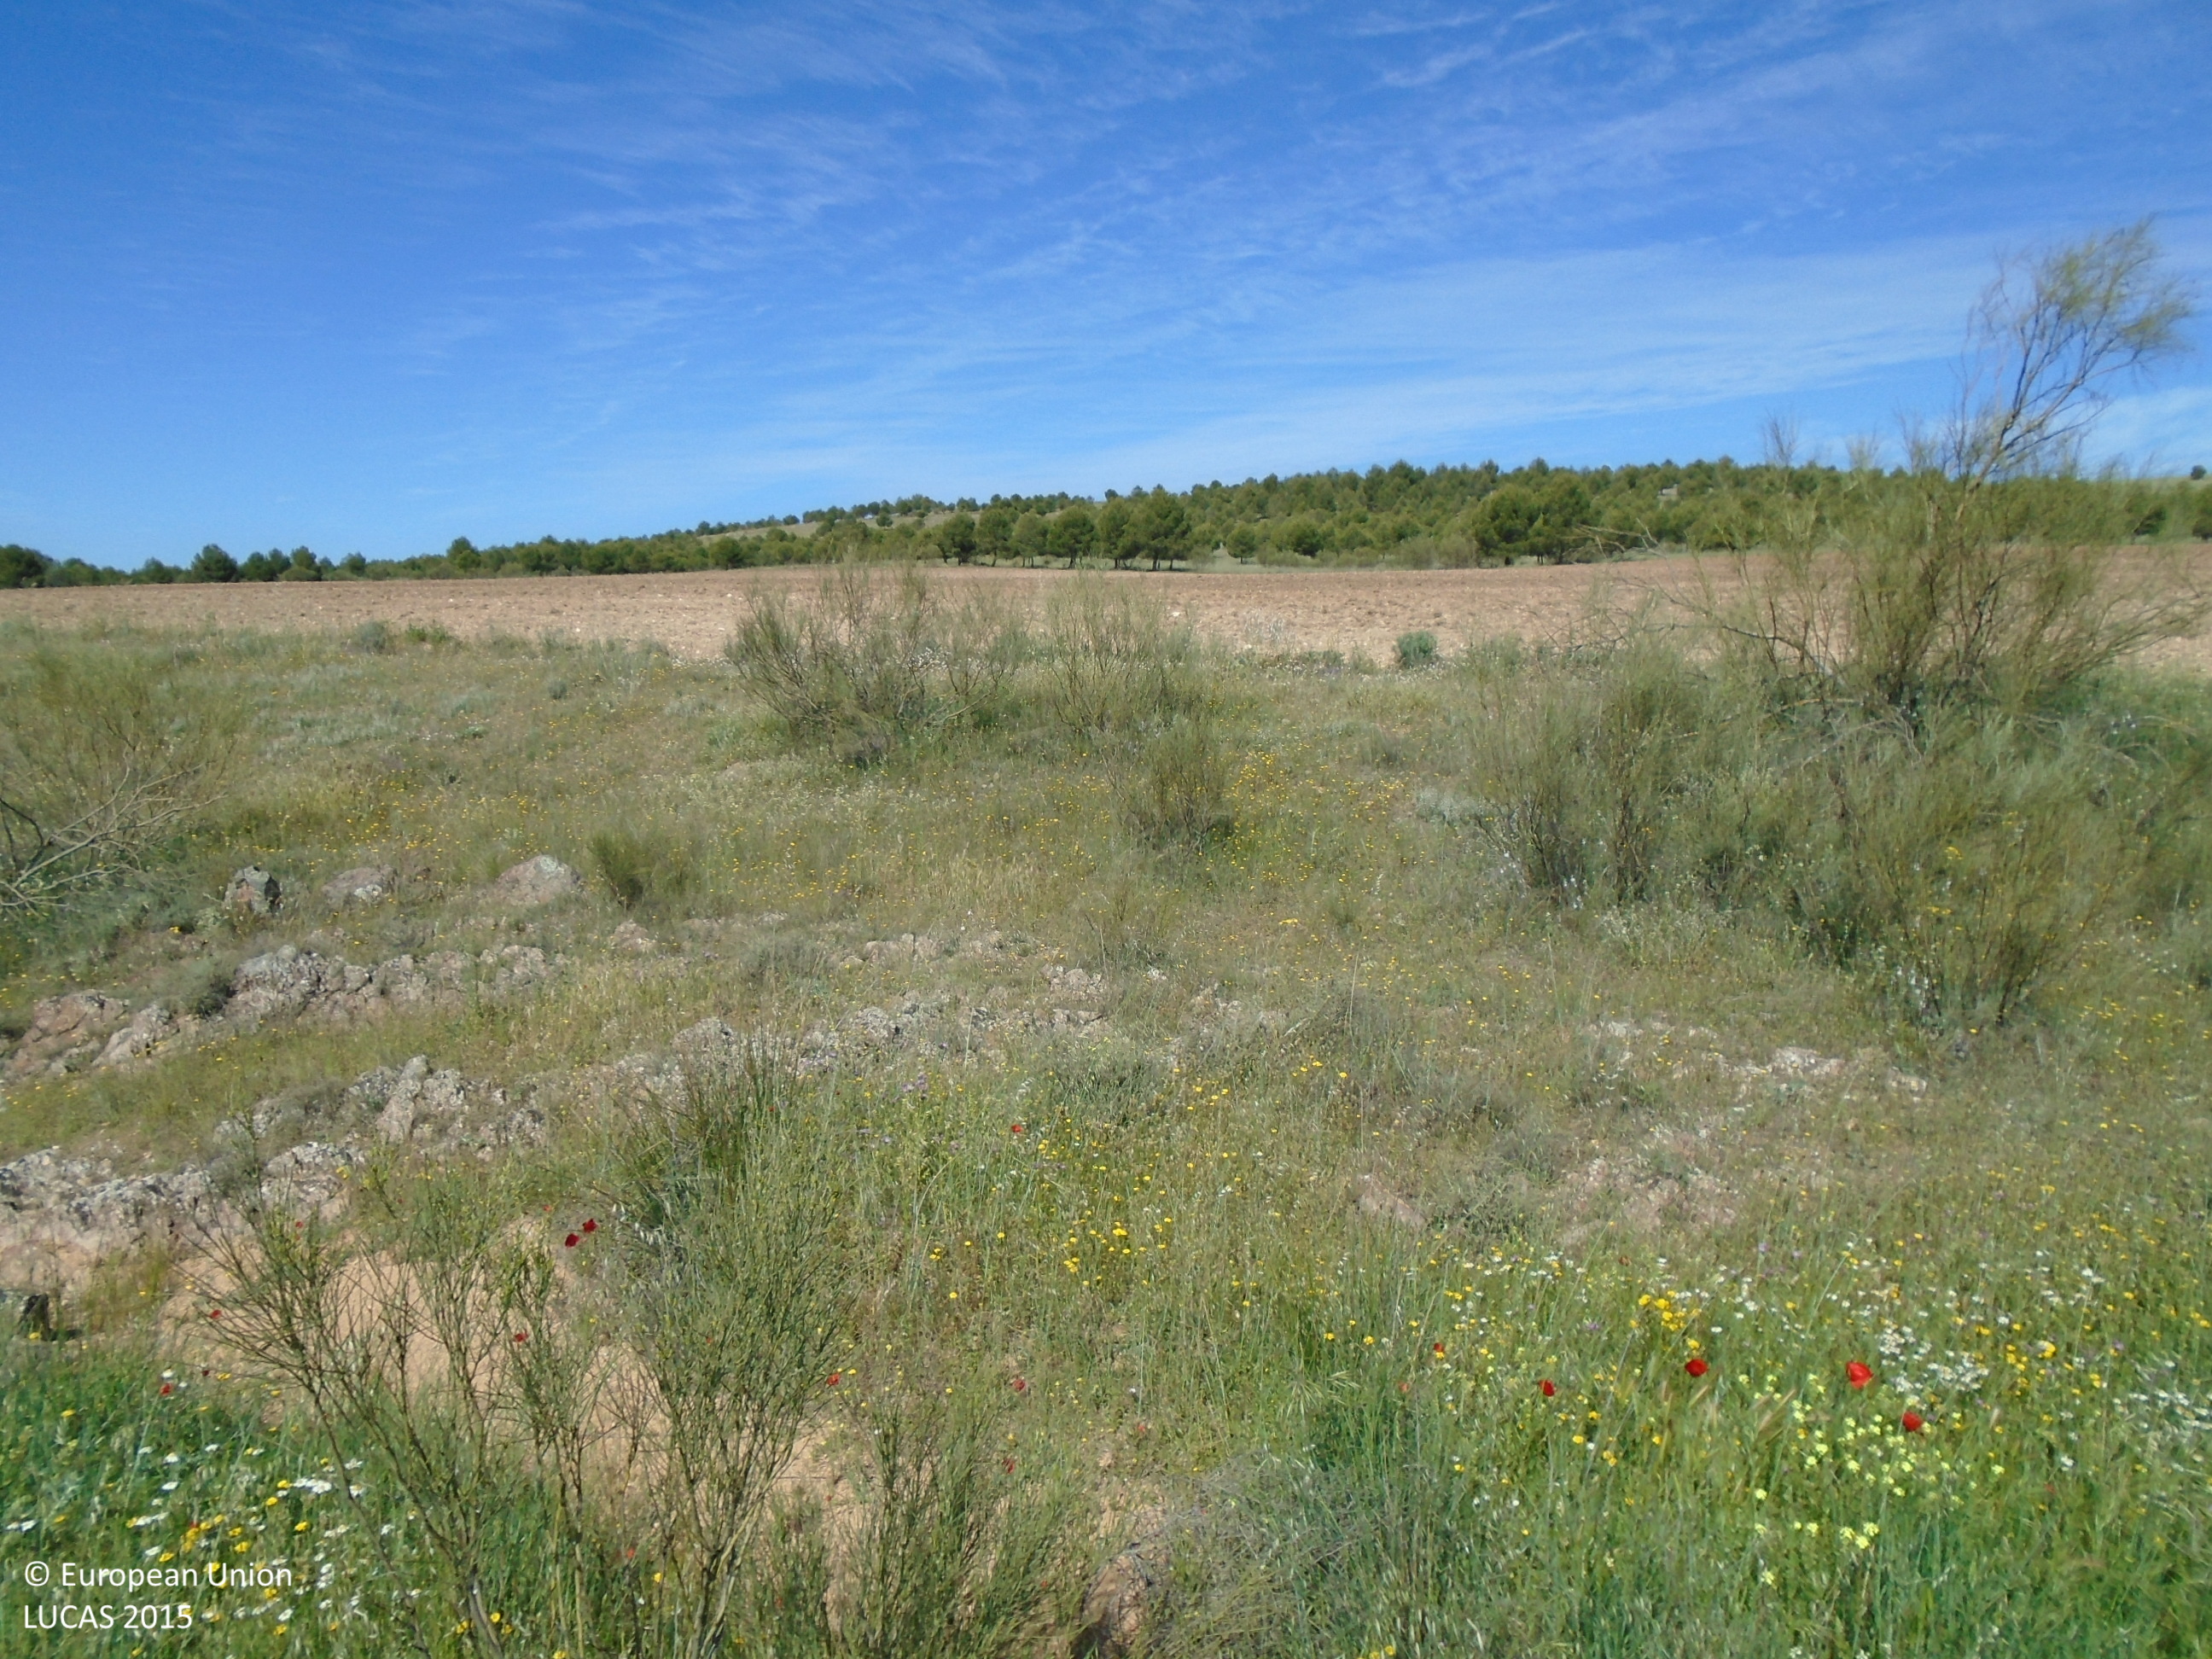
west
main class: Grassland
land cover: Grassland without tree/shrub cover
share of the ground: > 75 %
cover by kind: herbaceous plants 90 %, shrubs 5 %, consolidated bare surface 5 %
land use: Semi-natural and natural areas not in use
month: May
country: ES
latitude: 39.6417
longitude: -3.6248
